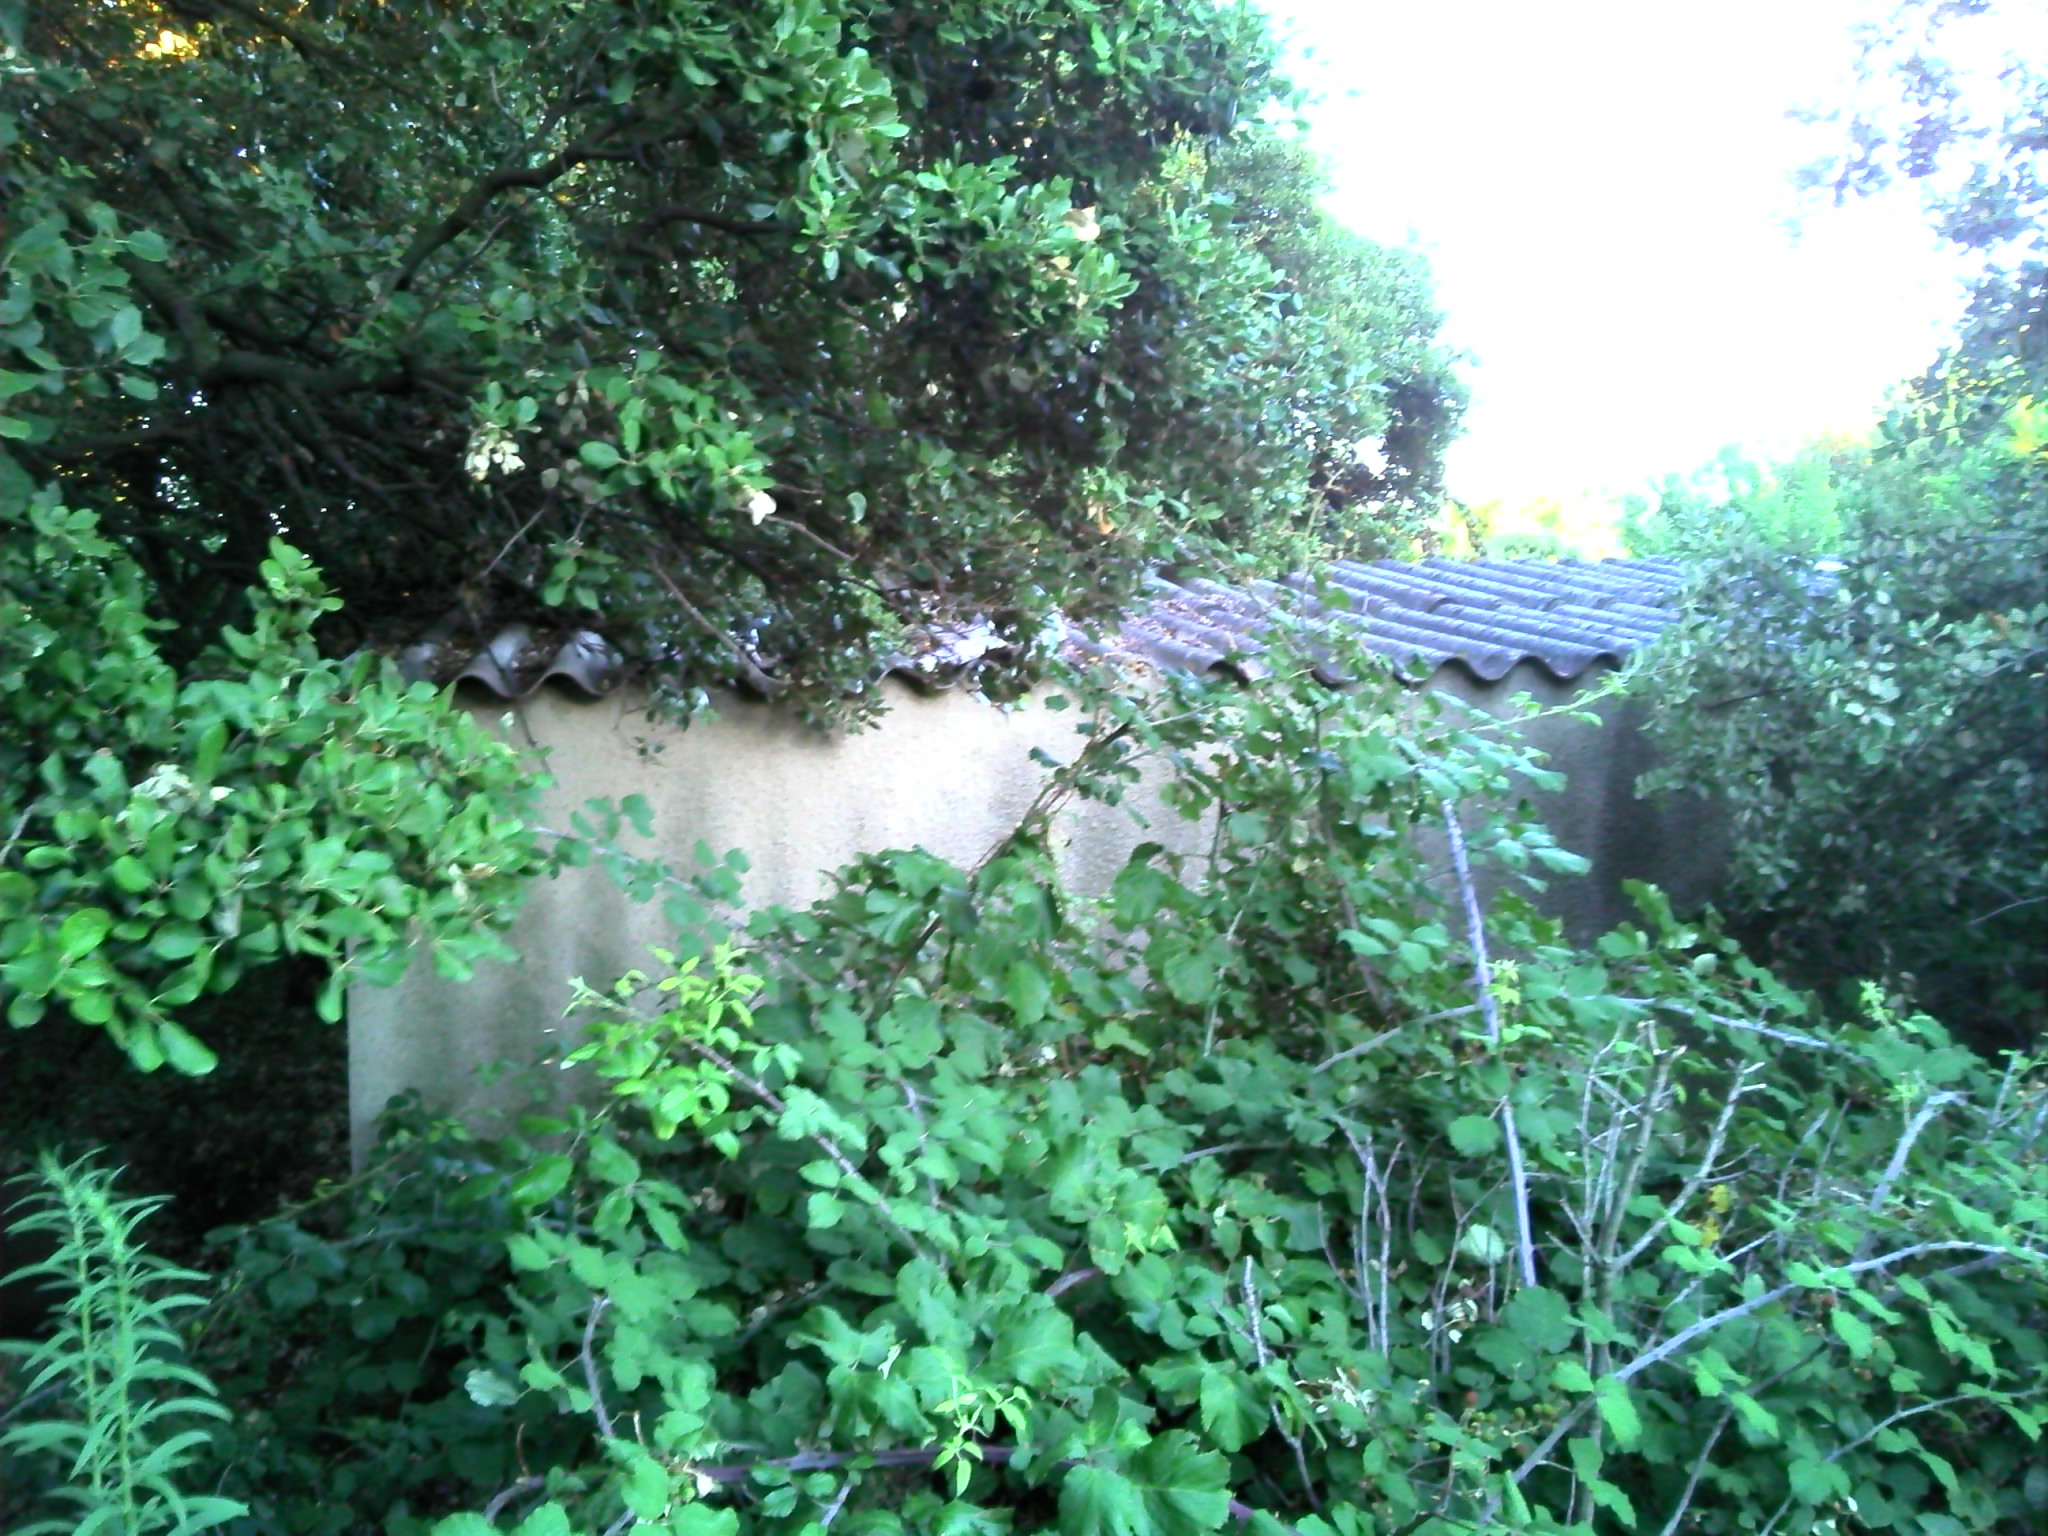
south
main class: Woodland
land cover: Broadleaved woodland
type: broadleaved evergreen forest
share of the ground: > 75 %
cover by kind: broadleaved forest trees 70 %, herbaceous plants 15 %, consolidated bare surface 15 %
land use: Forestry
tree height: > 5 m
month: August
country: FR
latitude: 43.9601
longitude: 4.6621
